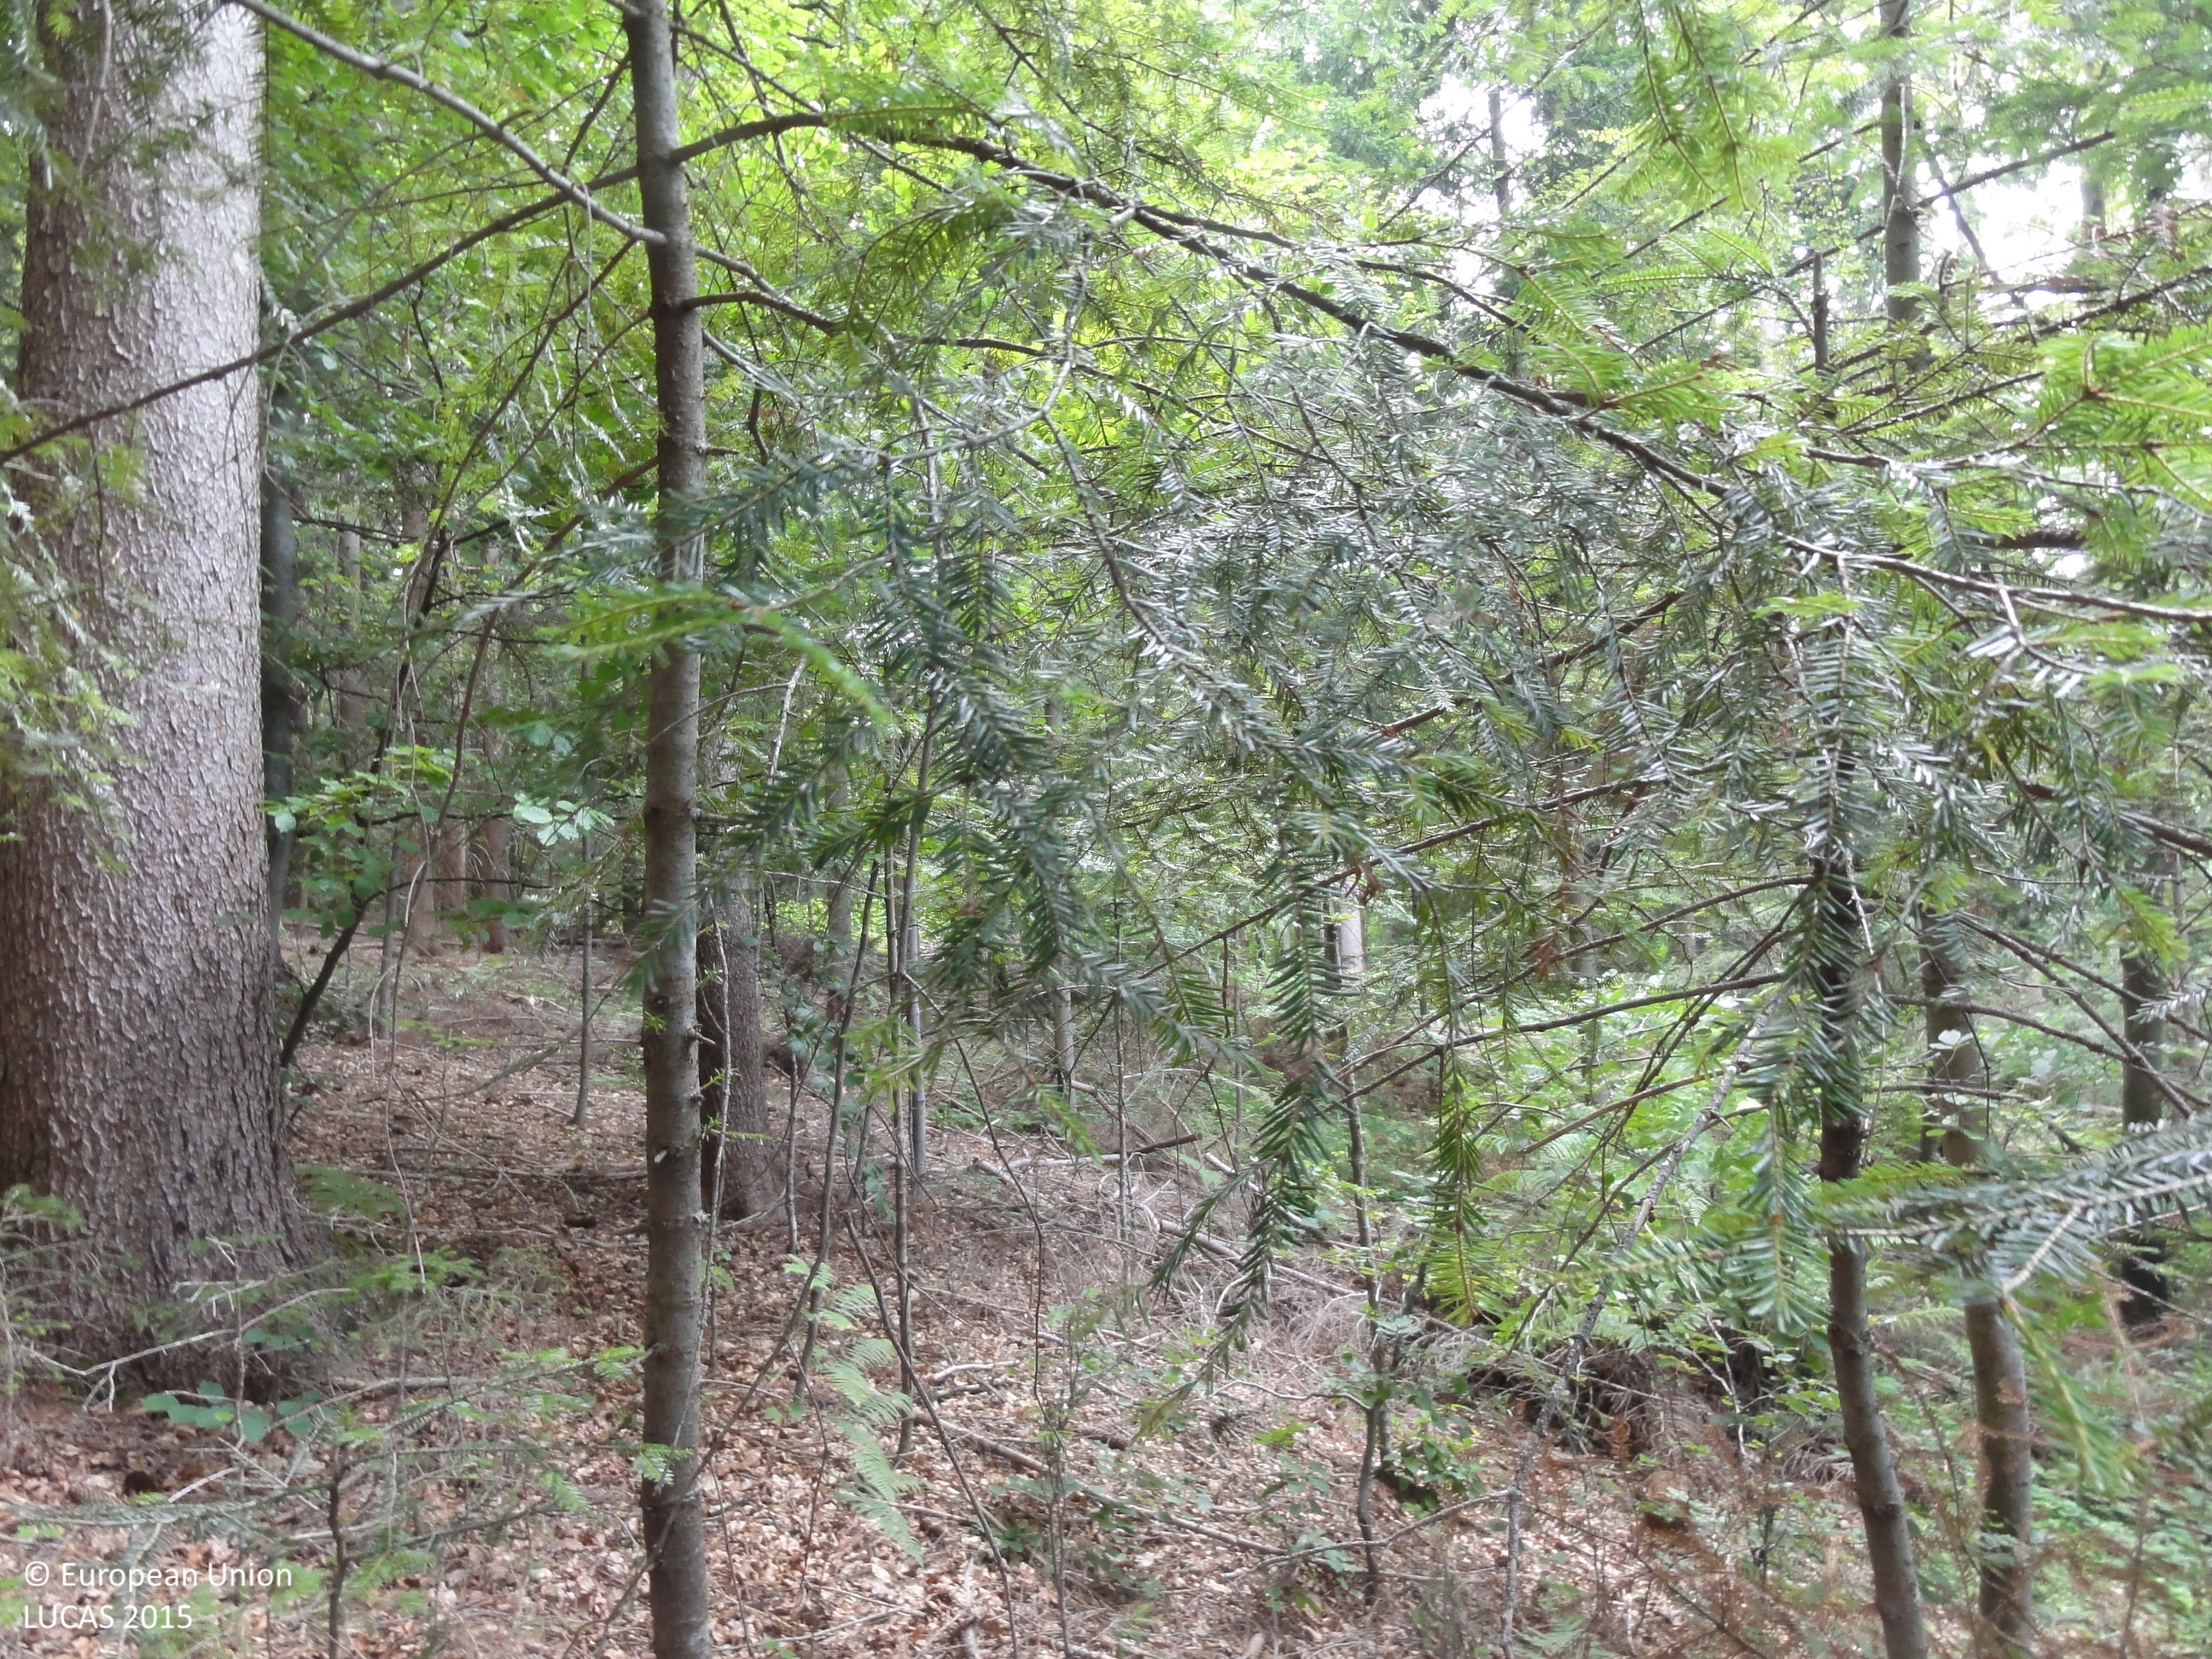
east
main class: Woodland
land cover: Spruce dominated mixed woodland
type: mountainous beech forest
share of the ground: > 75 %
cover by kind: coniferous forest trees 65 %, broadleaved forest trees 30 %, shrubs 5 %
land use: Forestry
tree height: > 5 m
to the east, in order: Spruce dominated mixed woodland; Tracks; Spruce dominated mixed woodland; Spruce dominated coniferous woodland; Spruce dominated mixed woodland; Tracks; Spruce dominated mixed woodland; Tracks; Spruce dominated mixed woodland; Tracks; Spruce dominated mixed woodland
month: June
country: SI
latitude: 46.3306
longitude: 14.8686
